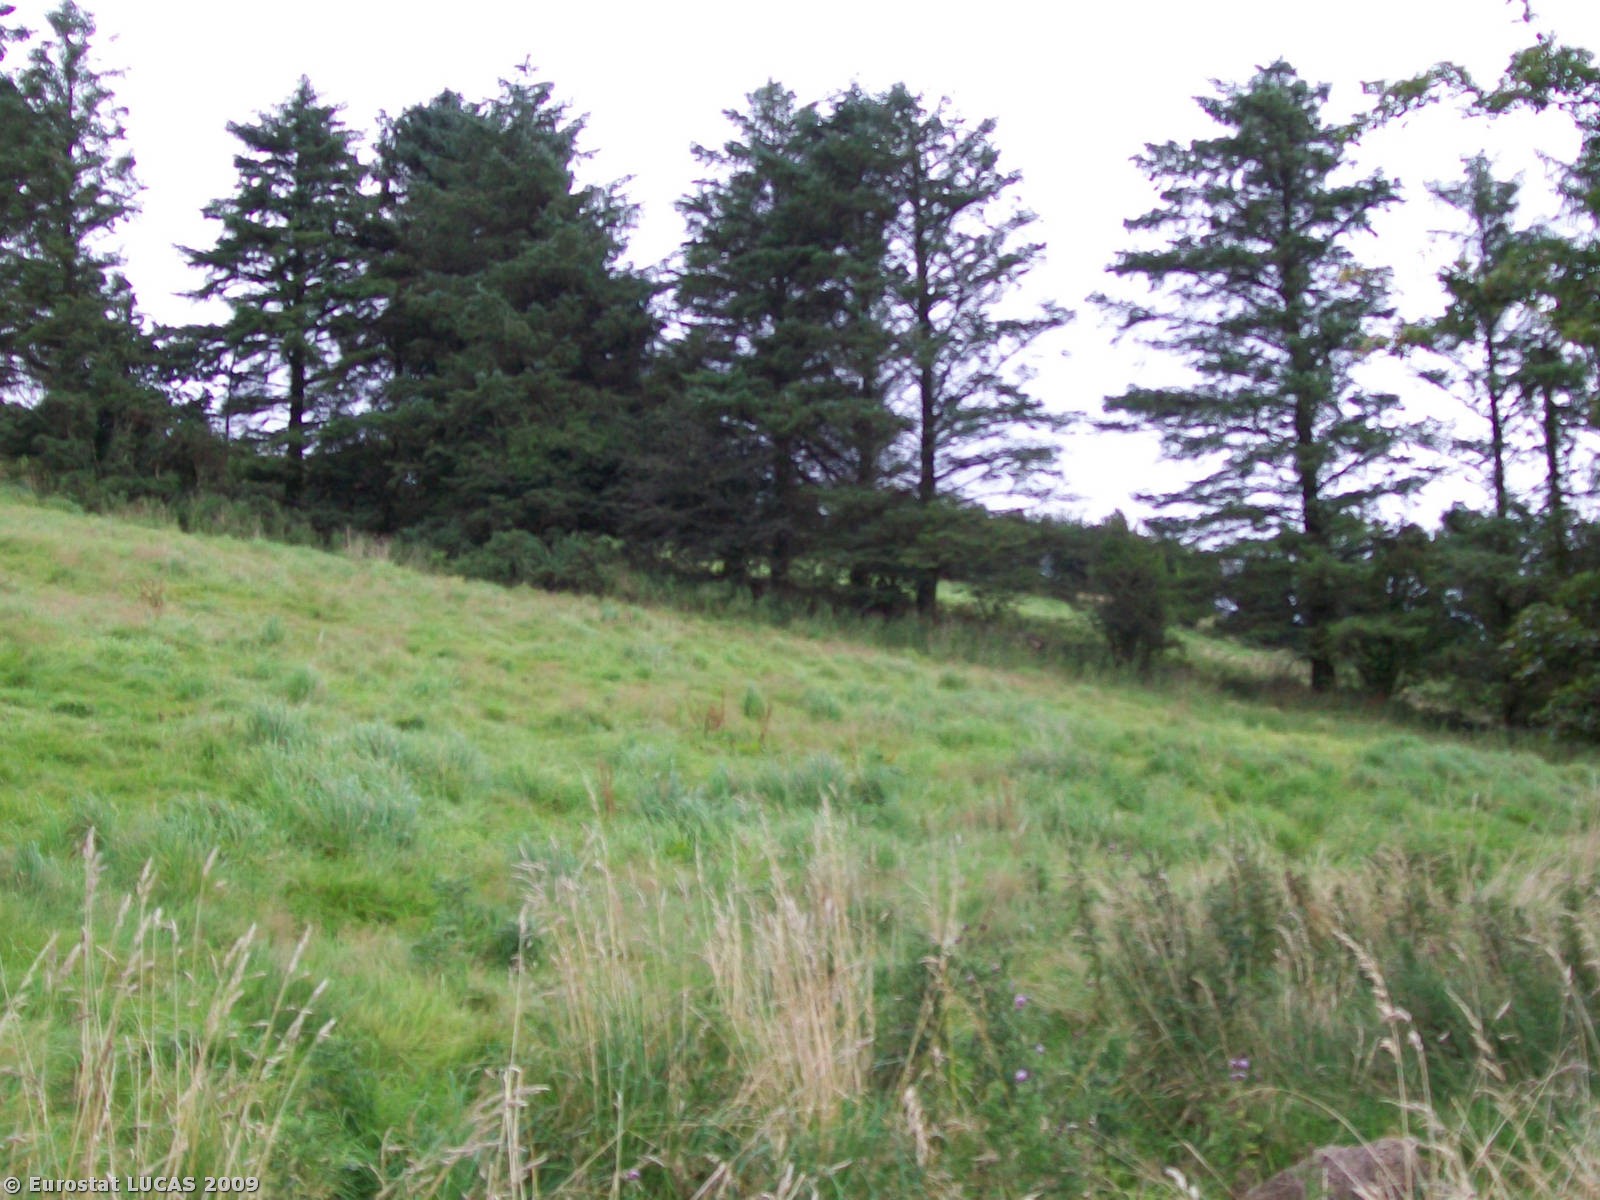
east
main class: Grassland
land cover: Grassland without tree/shrub cover
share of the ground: > 75 %
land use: Agriculture (excluding fallow land and kitchen gardens)
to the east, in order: Grassland without tree/shrub cover; Abandoned hedges; Grassland without tree/shrub cover; Abandoned hedges; Grassland without tree/shrub cover; Dry stone walls; Grassland without tree/shrub cover
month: August
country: IE
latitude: 52.9645
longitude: -8.6769
